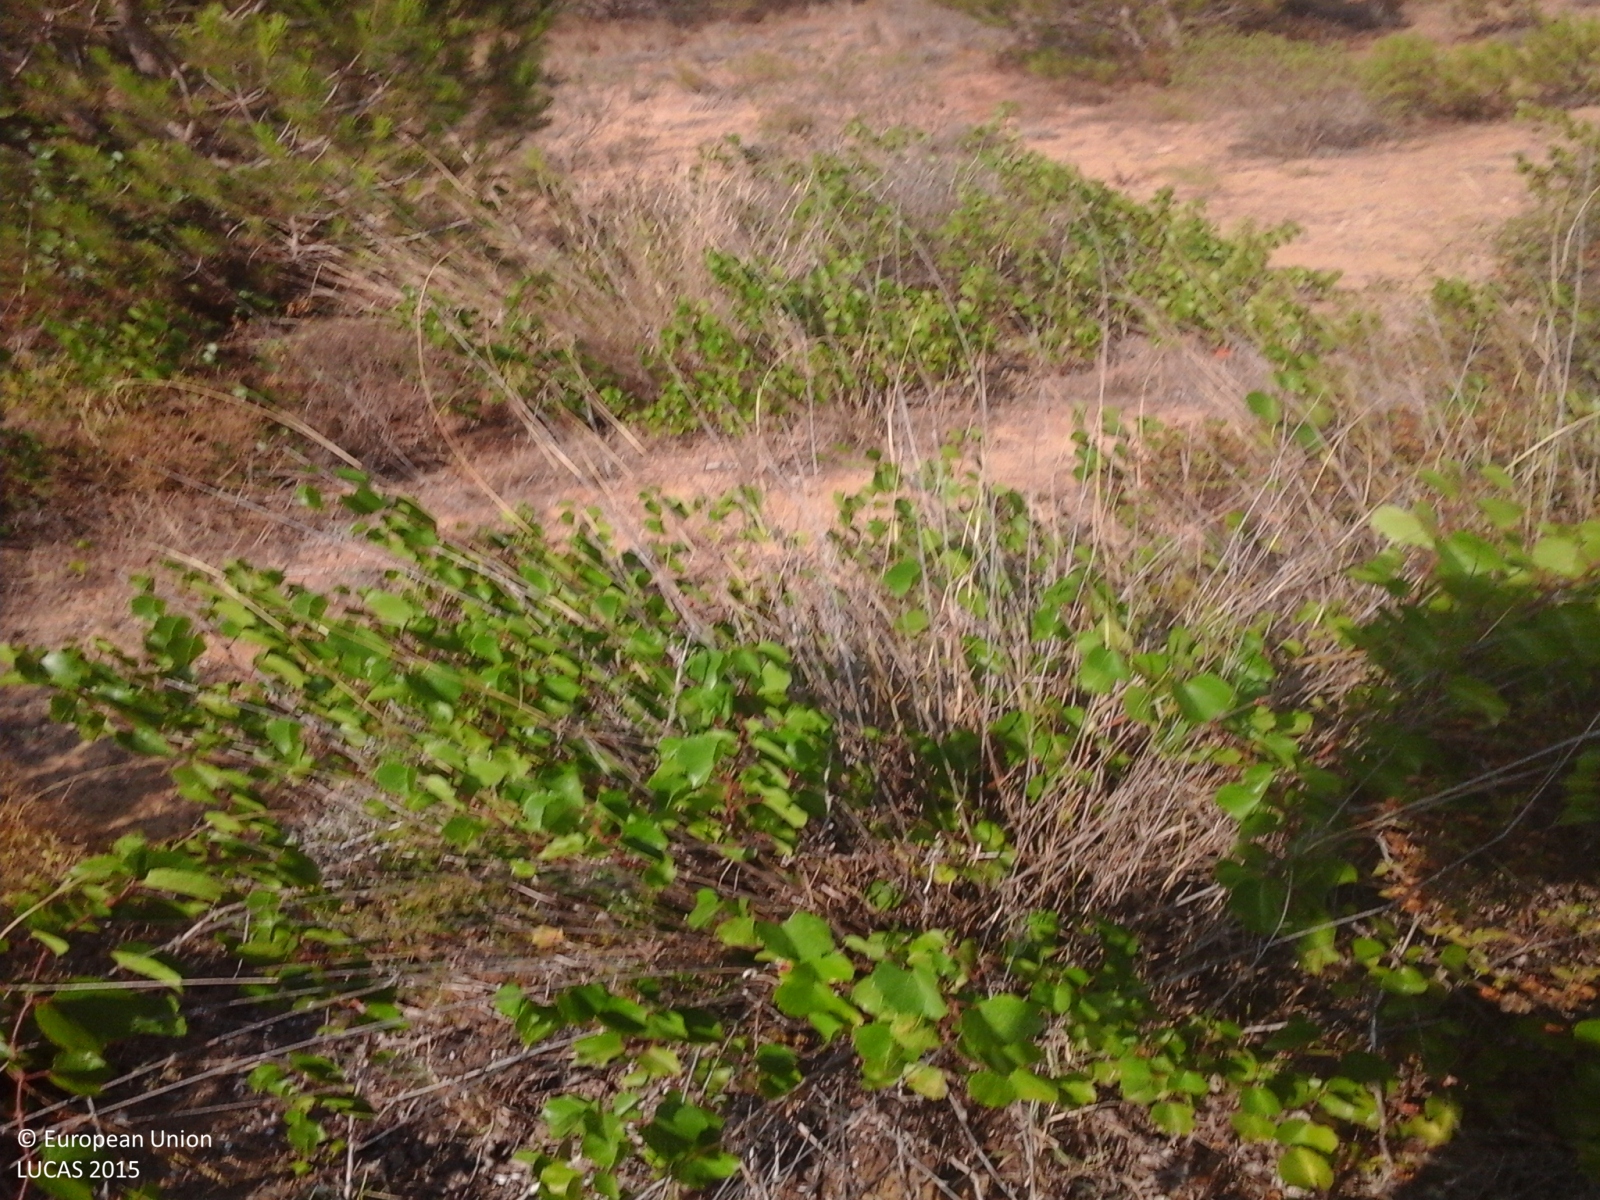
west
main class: Shrubland
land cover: Shrubland with sparse tree cover
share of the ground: > 75 %
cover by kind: shrubs 70 %, herbaceous plants 25 %, coniferous forest trees 5 %
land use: Semi-natural and natural areas not in use
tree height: < 5 m
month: July
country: IT
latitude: 37.0997
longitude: 14.4099
